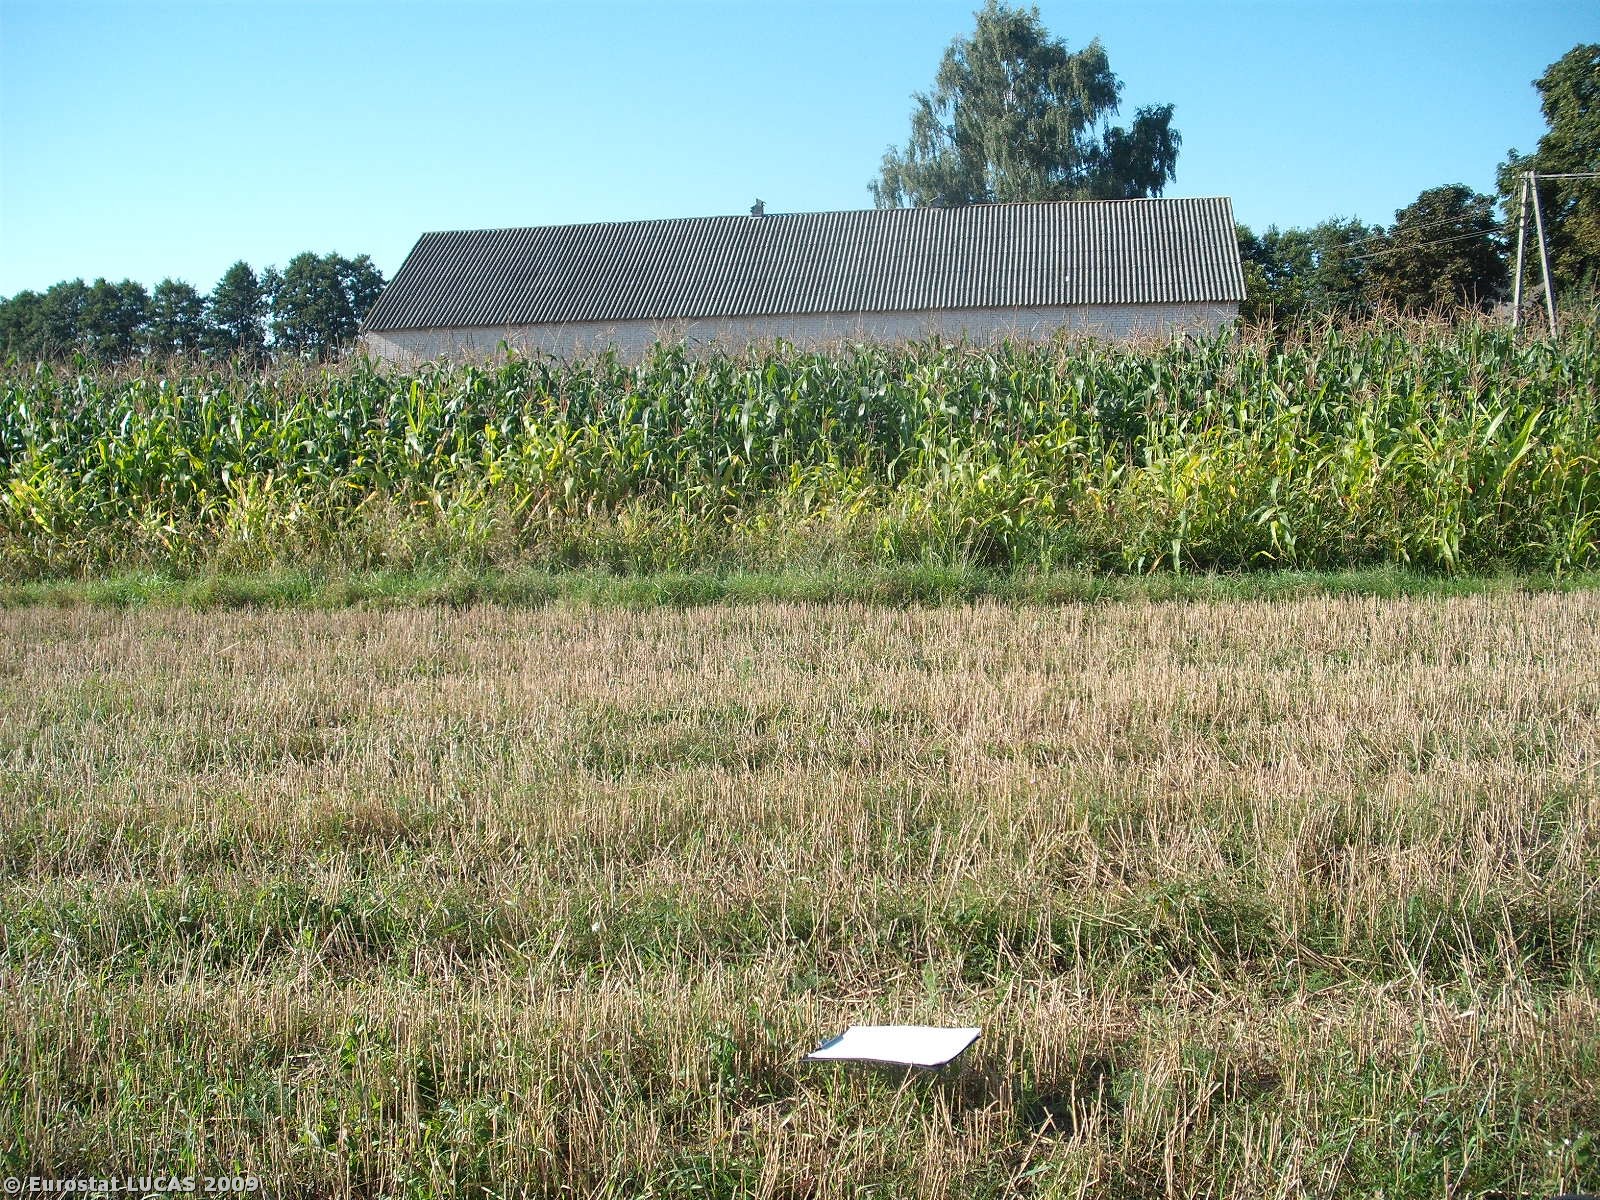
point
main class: Cropland
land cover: Triticale
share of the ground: < 10 %
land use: Agriculture (excluding fallow land and kitchen gardens)
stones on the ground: < 10 %
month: September
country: PL
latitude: 52.4754
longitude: 21.9983
